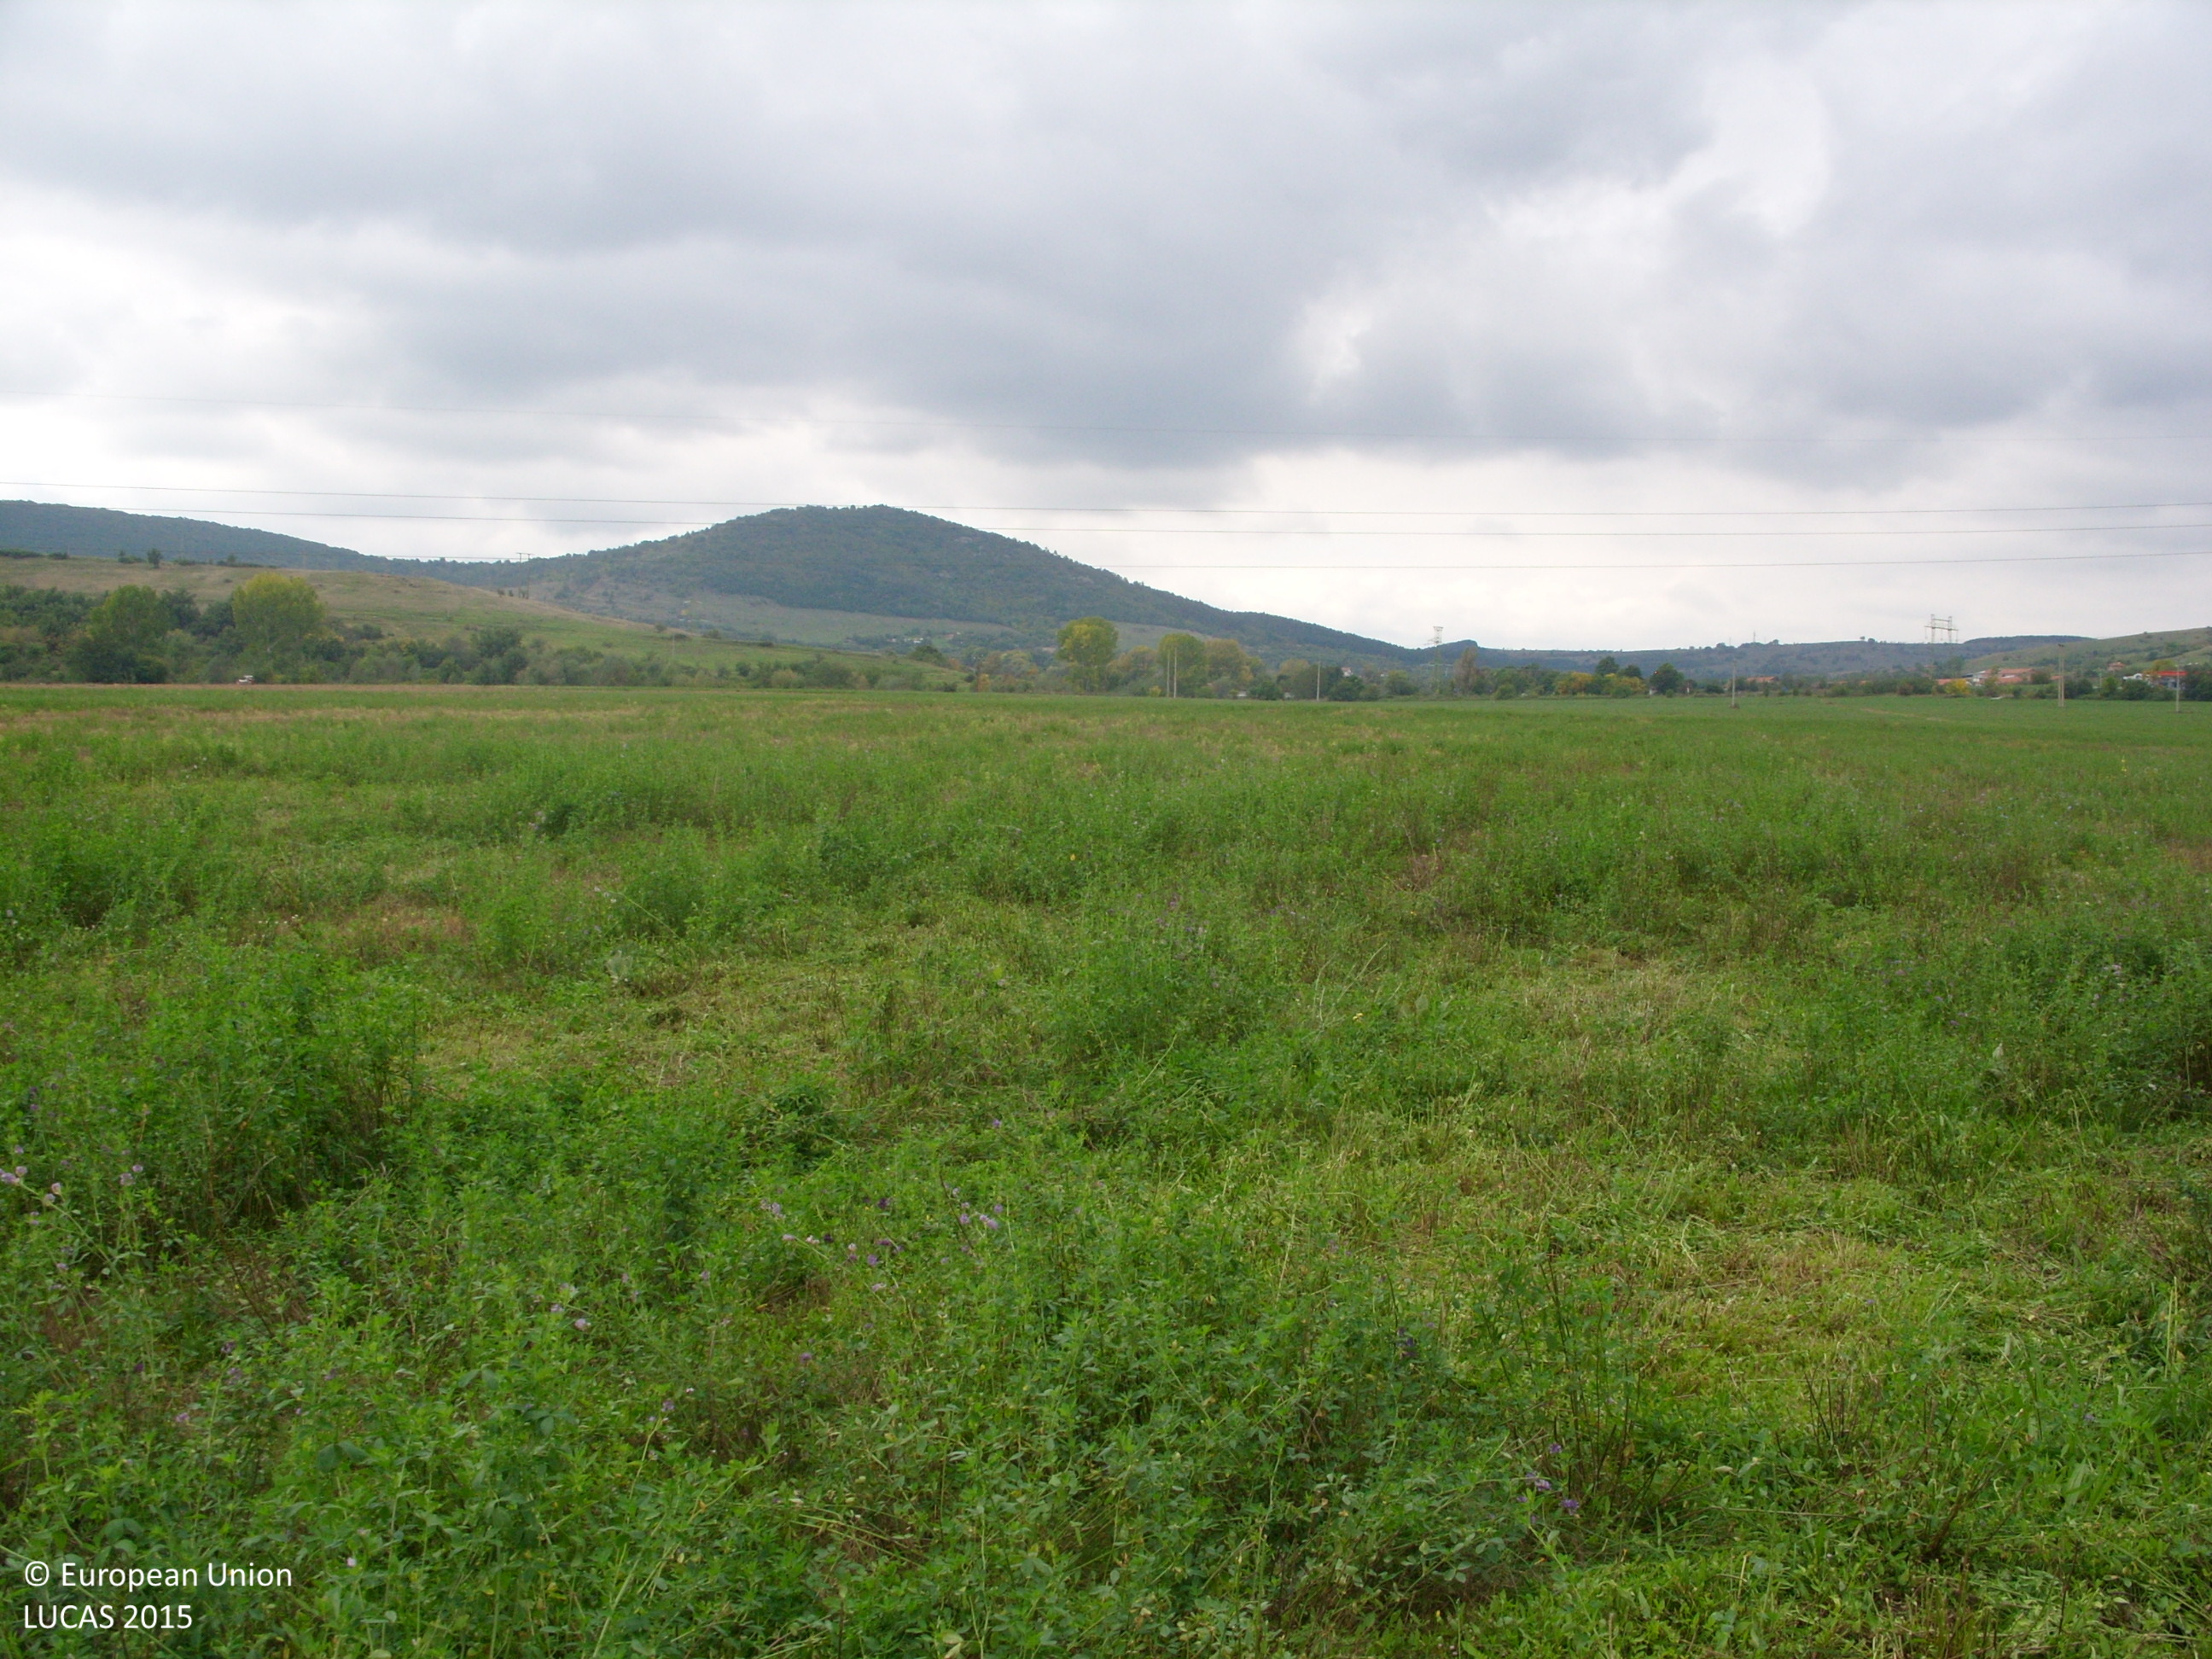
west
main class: Cropland
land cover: Lucerne
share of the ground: > 75 %
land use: Agriculture (excluding fallow land and kitchen gardens)
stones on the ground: < 10 %
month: October
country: BG
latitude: 42.5277
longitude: 24.8242
